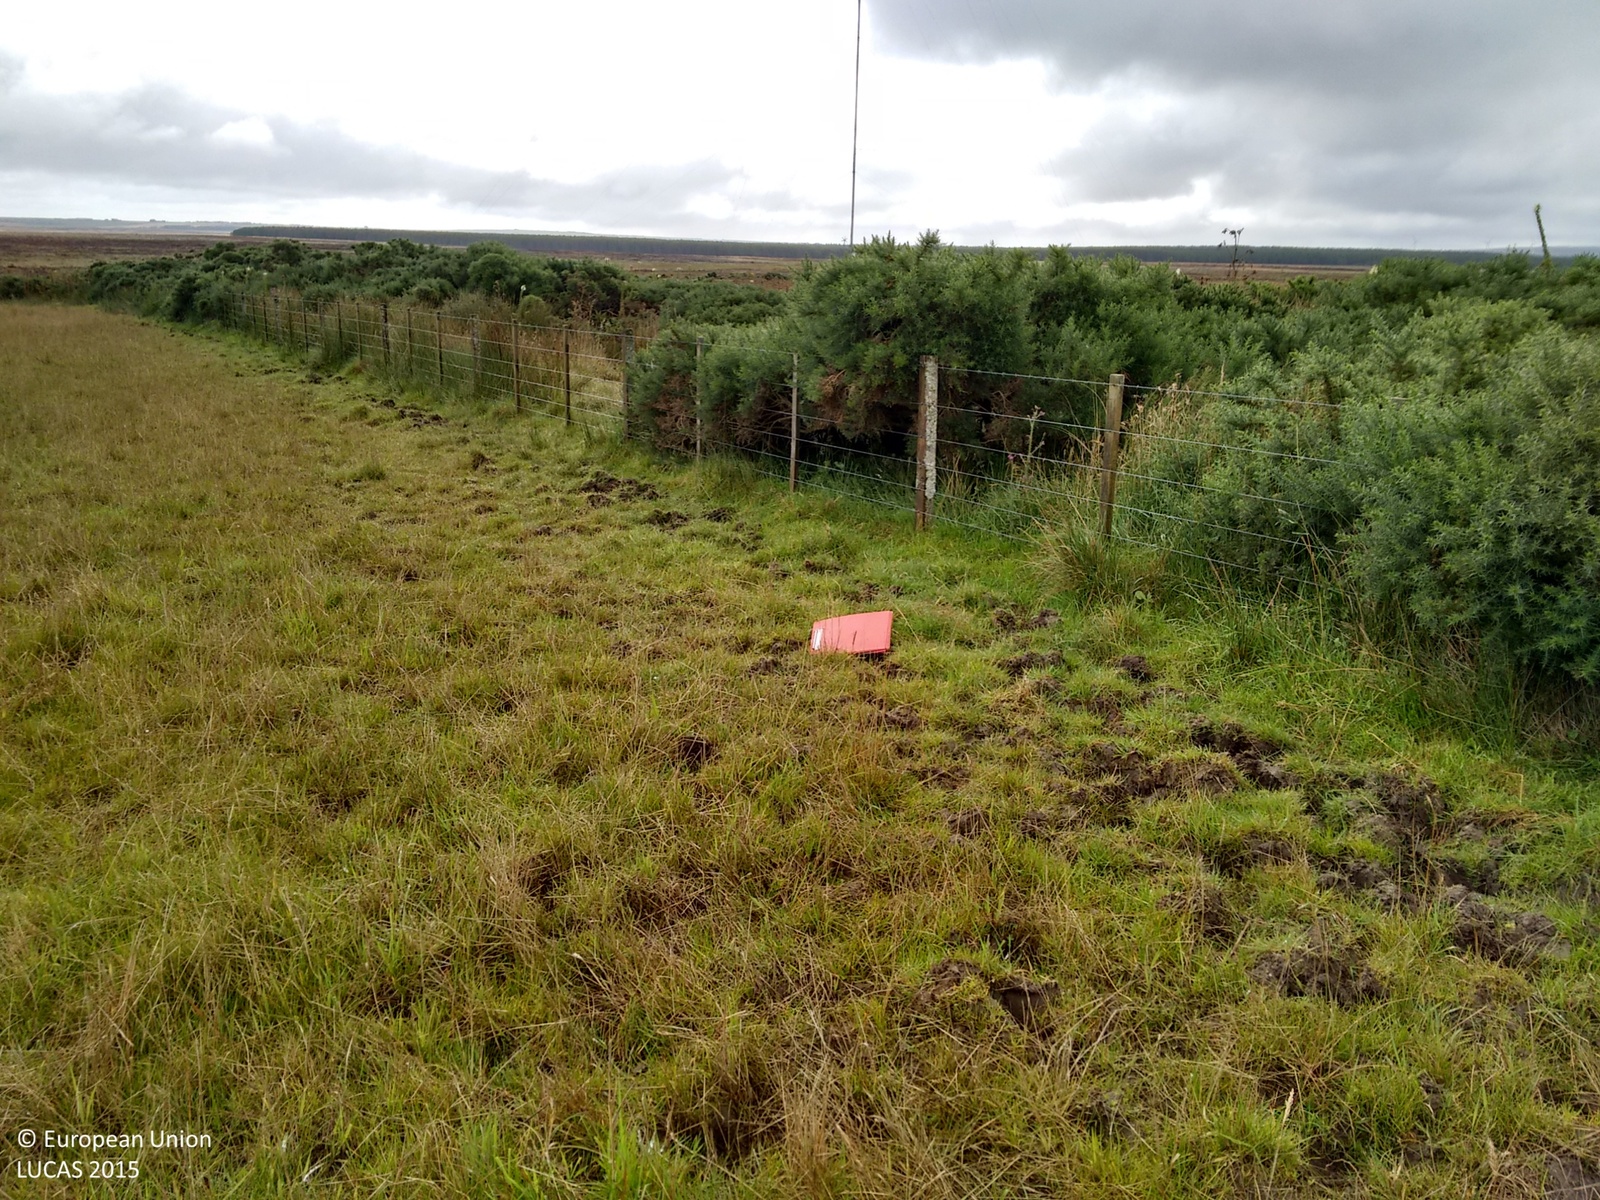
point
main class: Grassland
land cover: Grassland without tree/shrub cover
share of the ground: > 75 %
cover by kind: herbaceous plants 100 %
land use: Agriculture (excluding fallow land and kitchen gardens)
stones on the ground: < 10 %
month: August
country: GB
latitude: 58.4912
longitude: -3.2522
